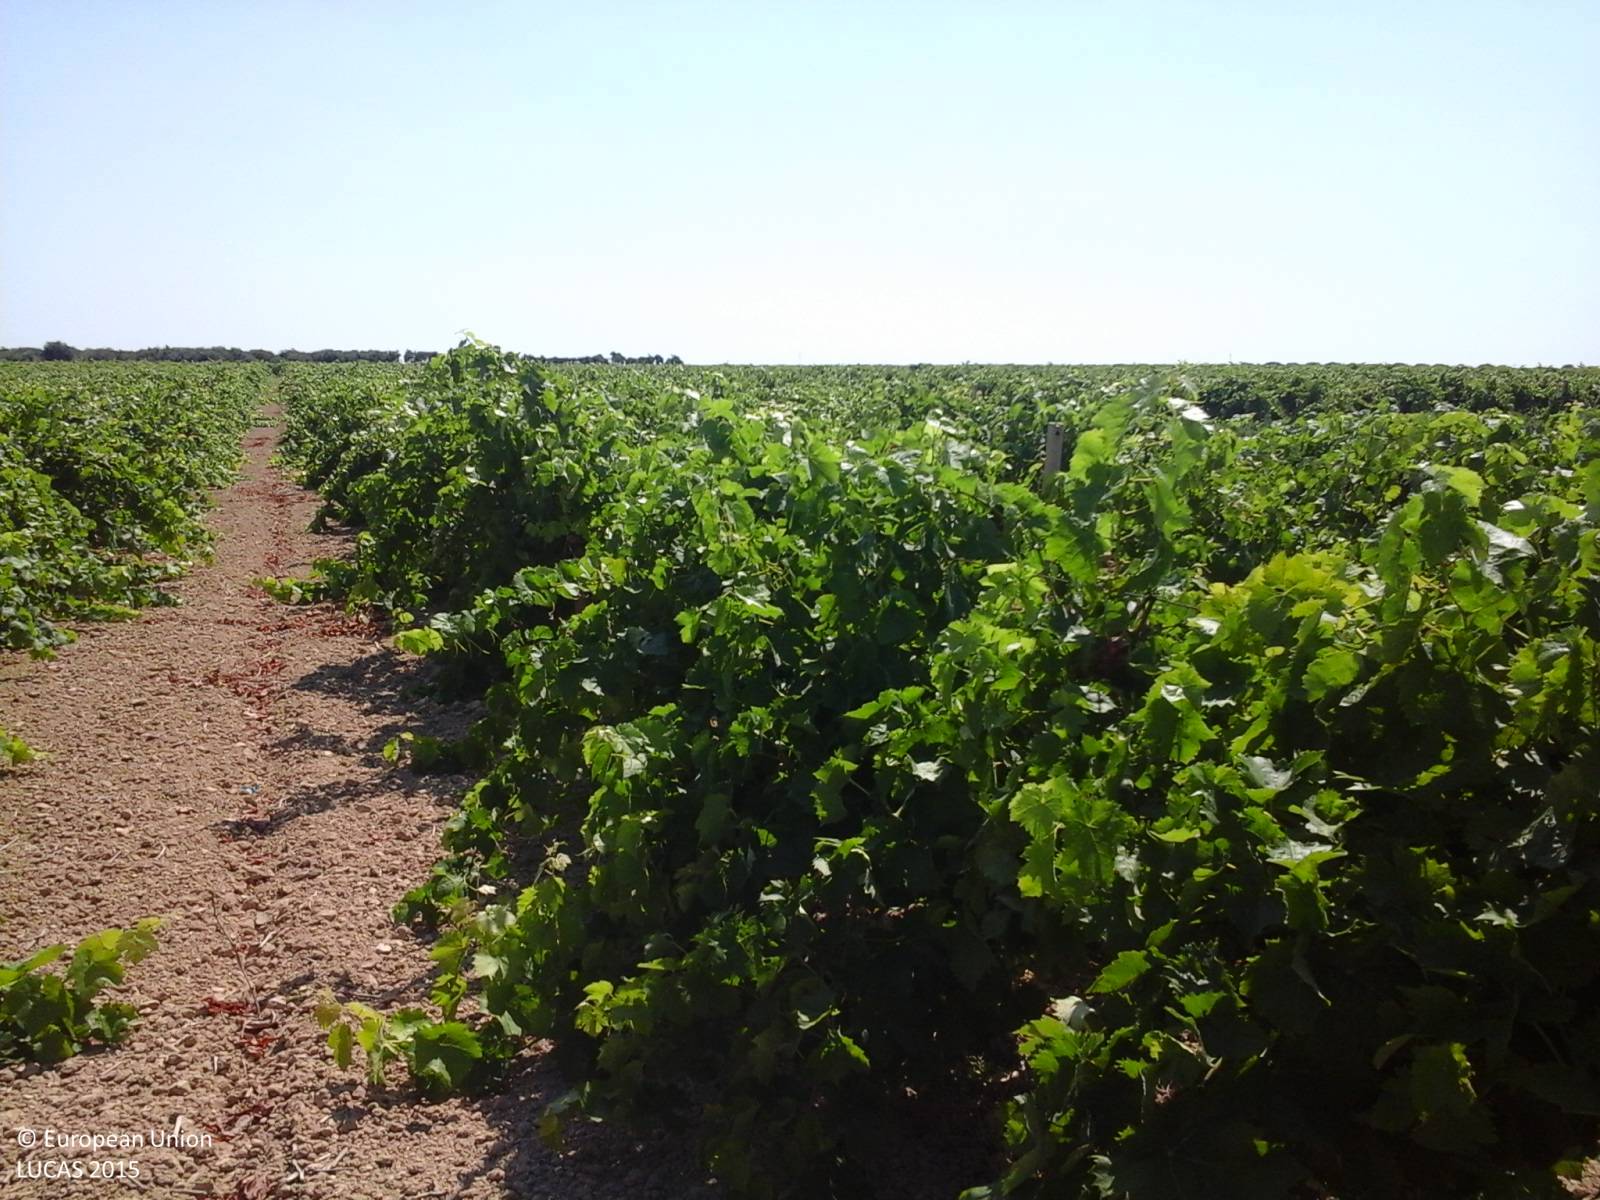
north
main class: Cropland
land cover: Vineyards
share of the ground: 50 - 75 %
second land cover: Other bare soil
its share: > 75 %
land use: Agriculture (excluding fallow land and kitchen gardens)
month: July
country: IT
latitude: 37.7477
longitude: 12.6246
